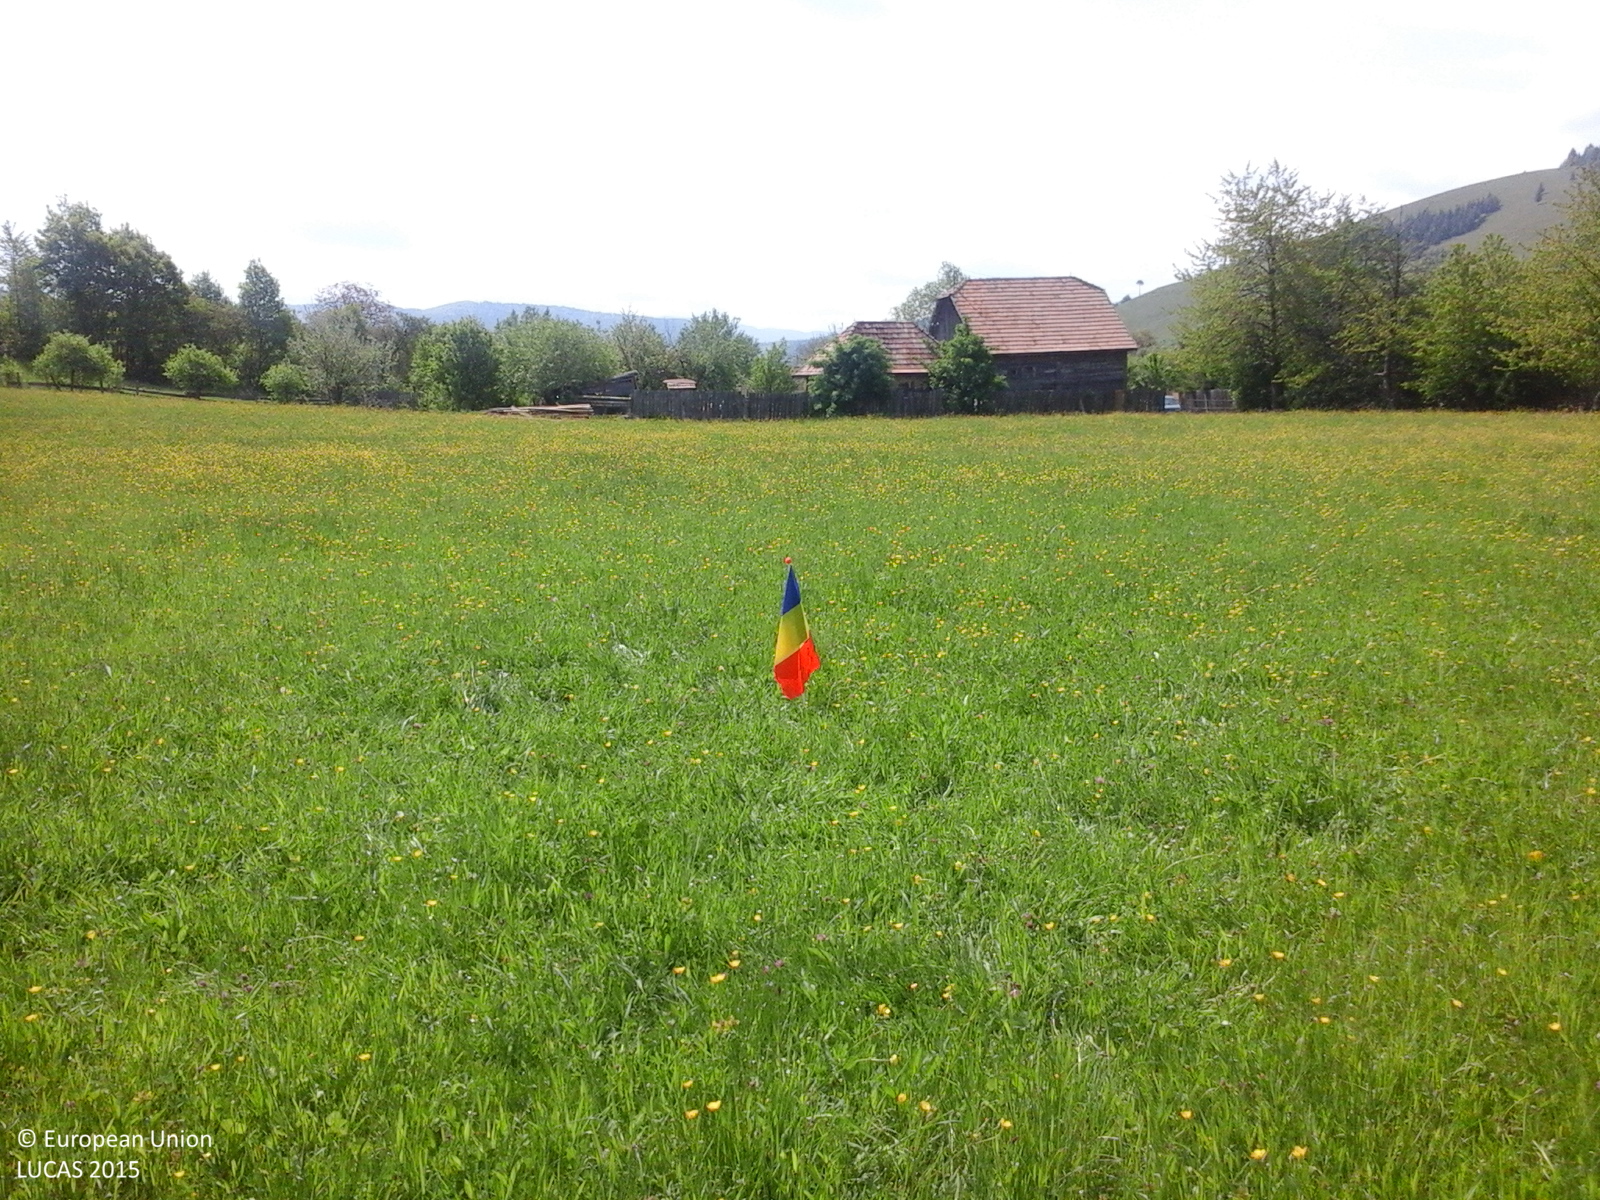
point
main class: Grassland
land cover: Grassland without tree/shrub cover
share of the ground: > 75 %
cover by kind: herbaceous plants 100 %
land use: Agriculture (excluding fallow land and kitchen gardens)
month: May
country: RO
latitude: 45.9761
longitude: 26.2702
